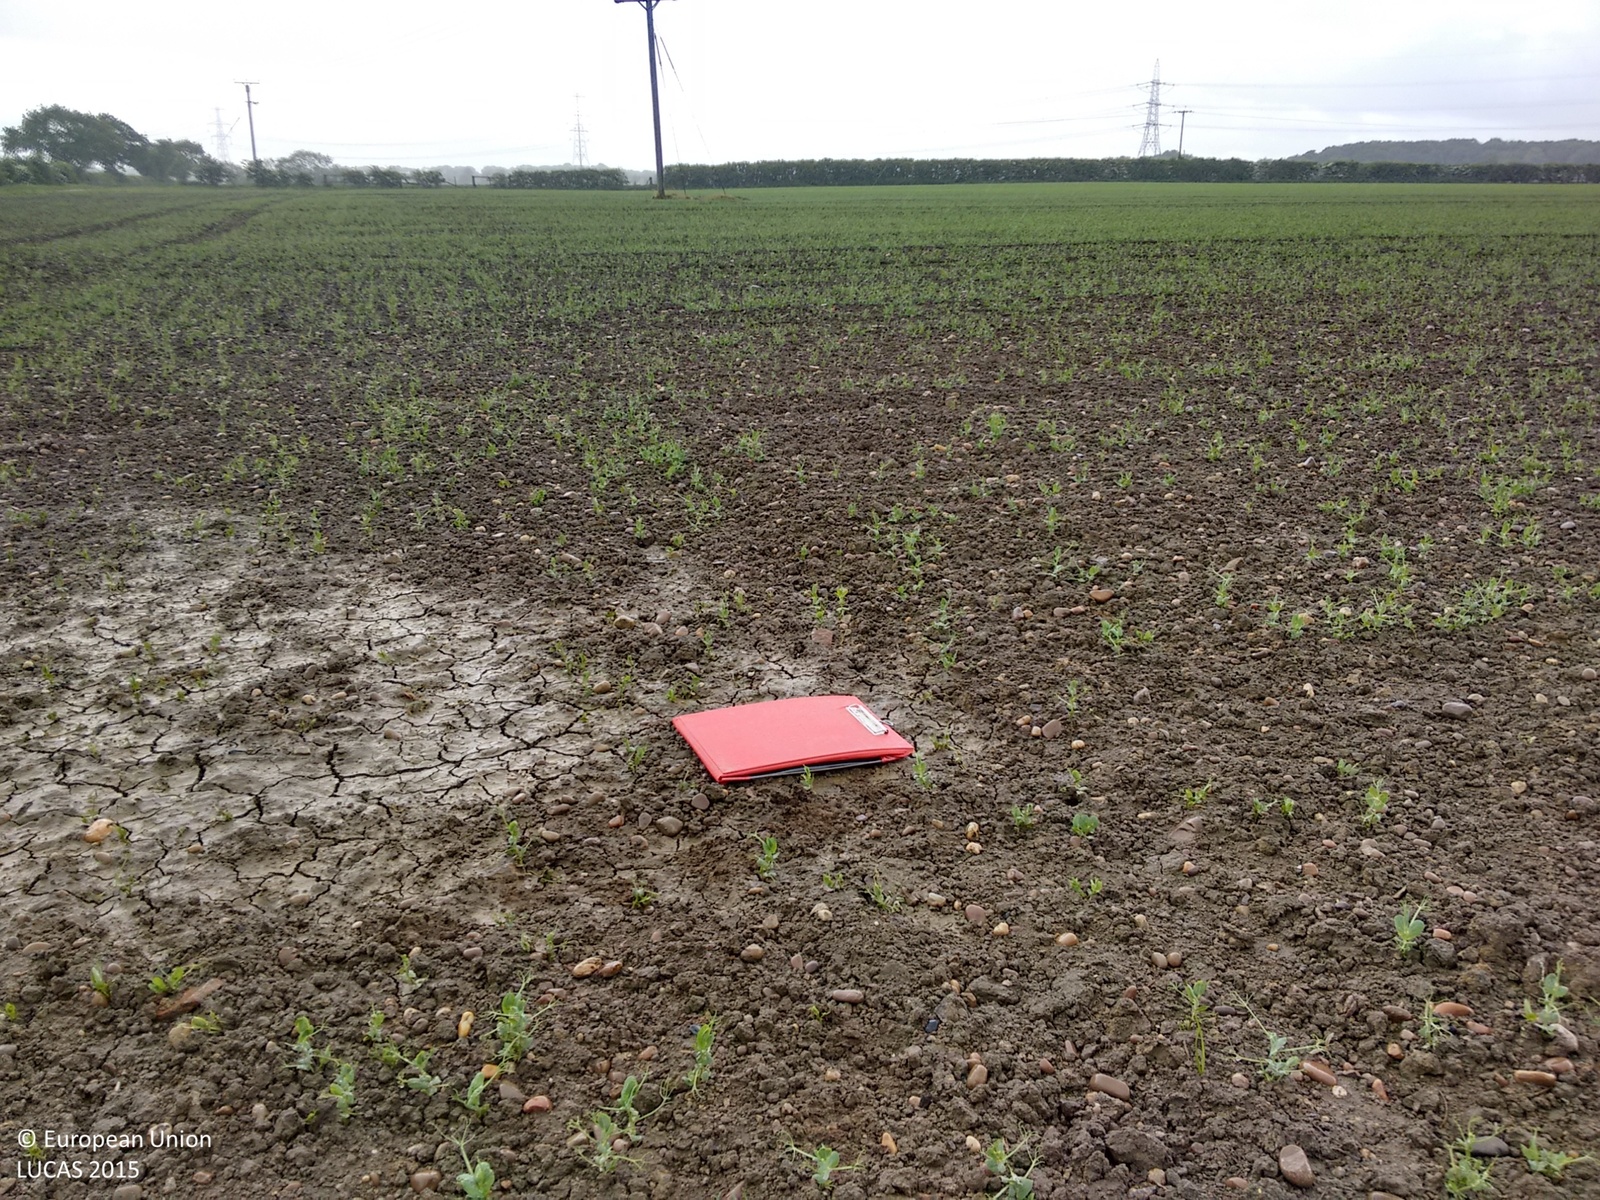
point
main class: Cropland
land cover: Dry pulses
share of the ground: 10 - 25 %
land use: Agriculture (excluding fallow land and kitchen gardens)
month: May
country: GB
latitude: 53.5661
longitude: -1.0511
